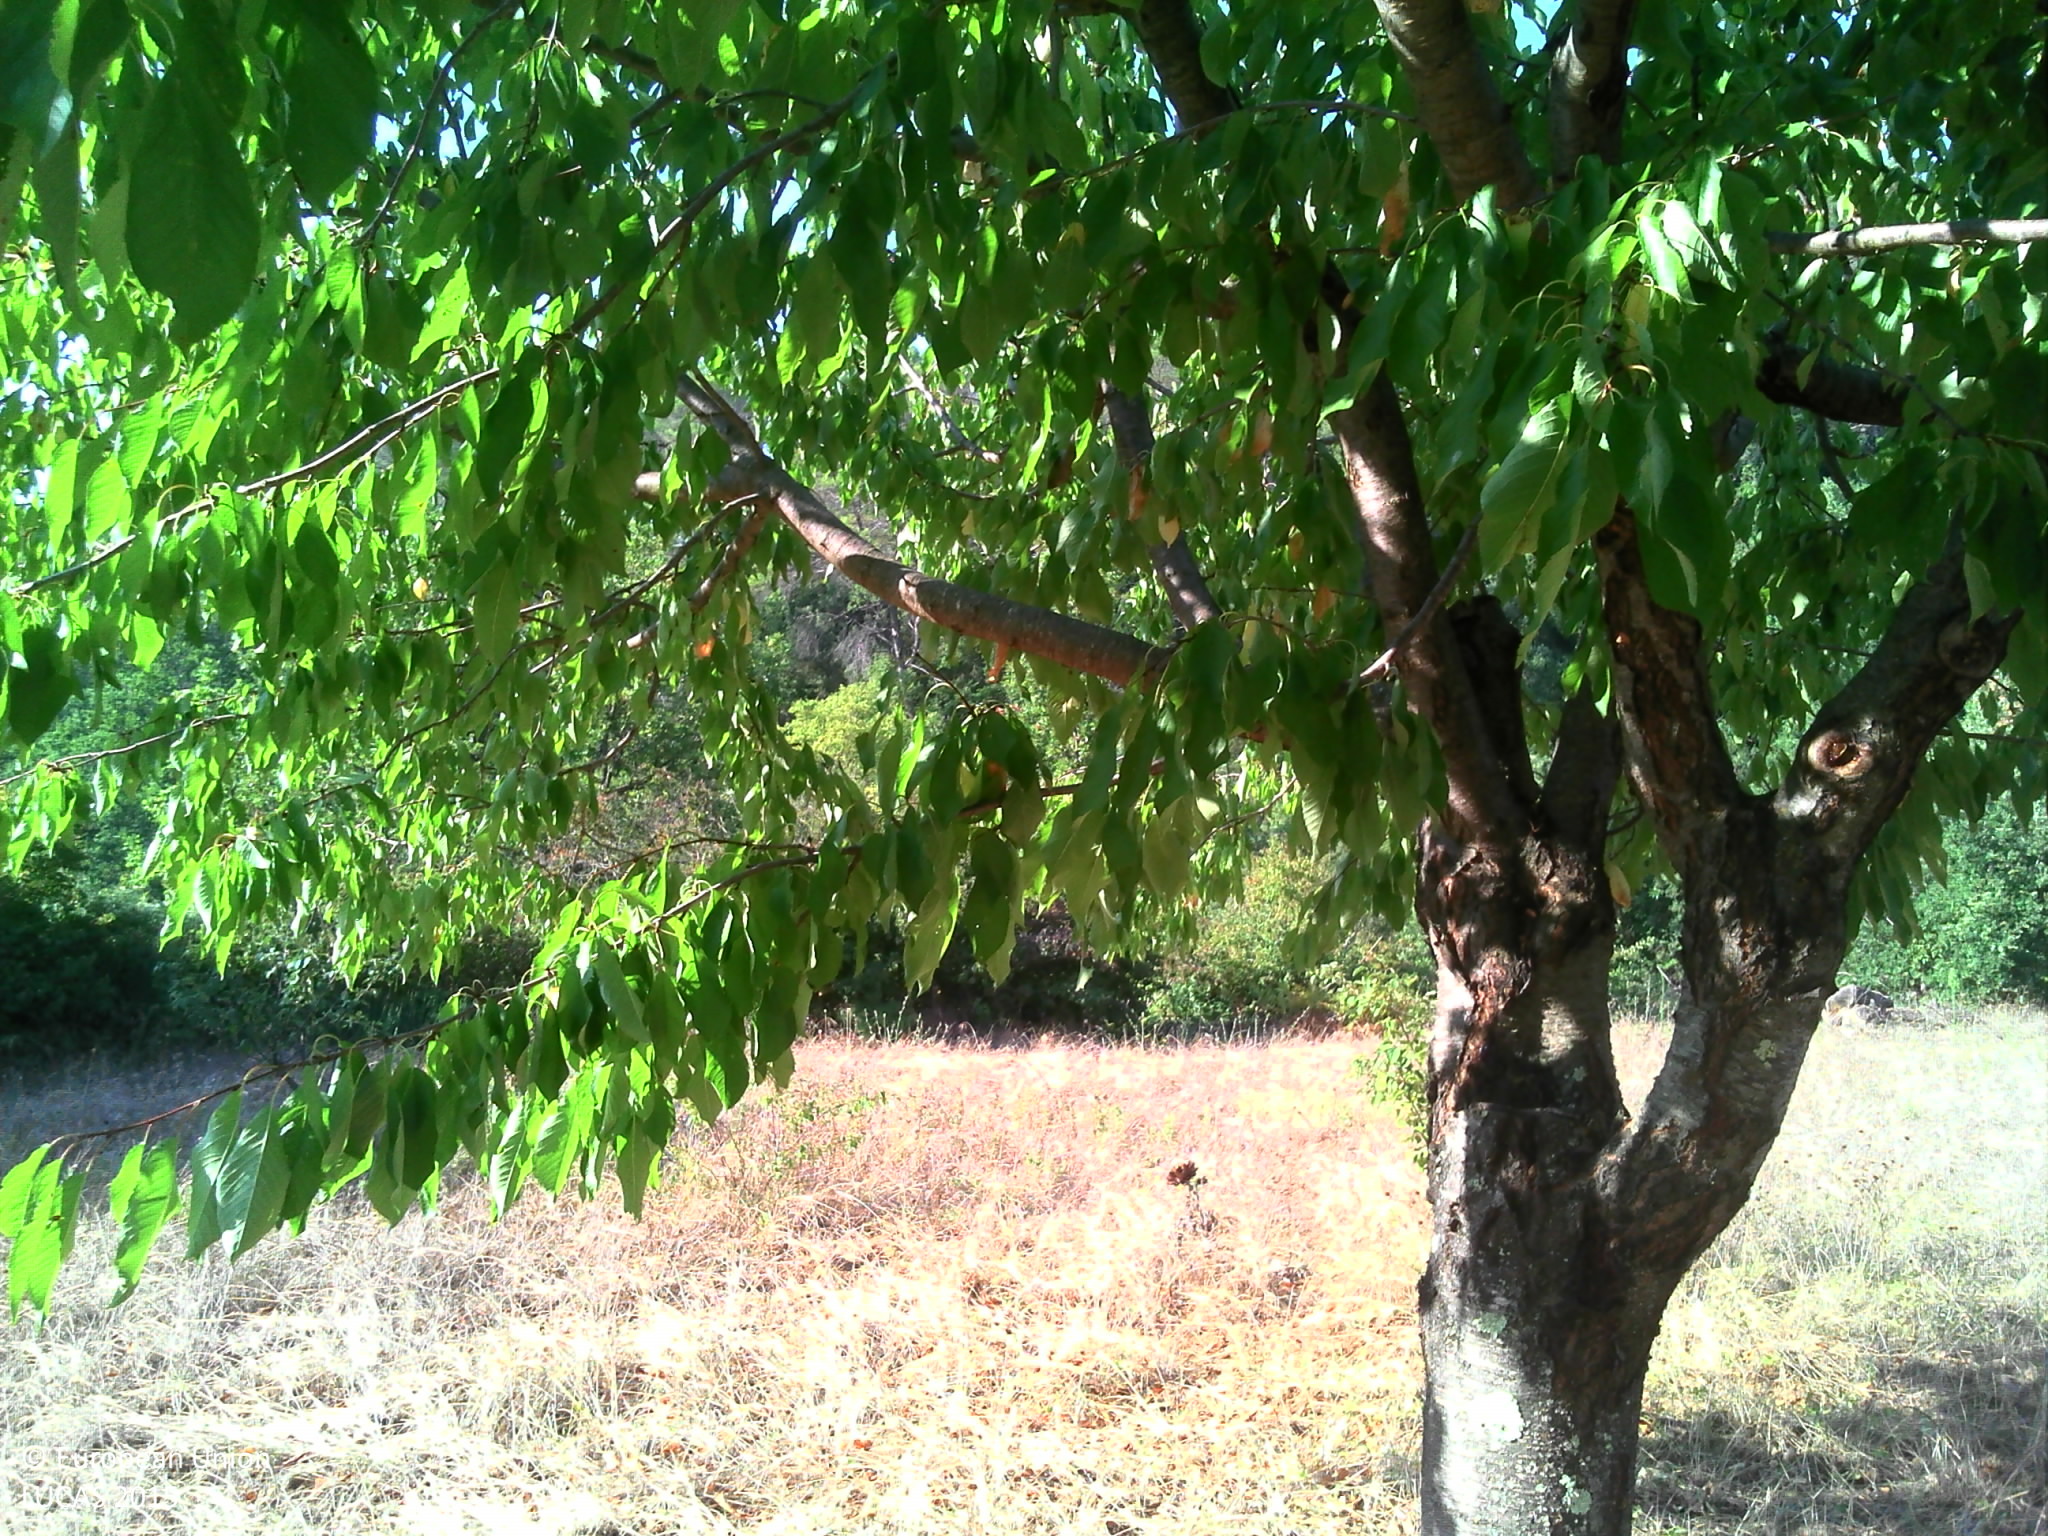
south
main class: Grassland
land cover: Grassland with sparse tree/shrub cover
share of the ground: > 75 %
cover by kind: herbaceous plants 95 %, broadleaved forest trees 5 %
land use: Residential
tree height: > 5 m
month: August
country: FR
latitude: 43.5111
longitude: 6.3843
